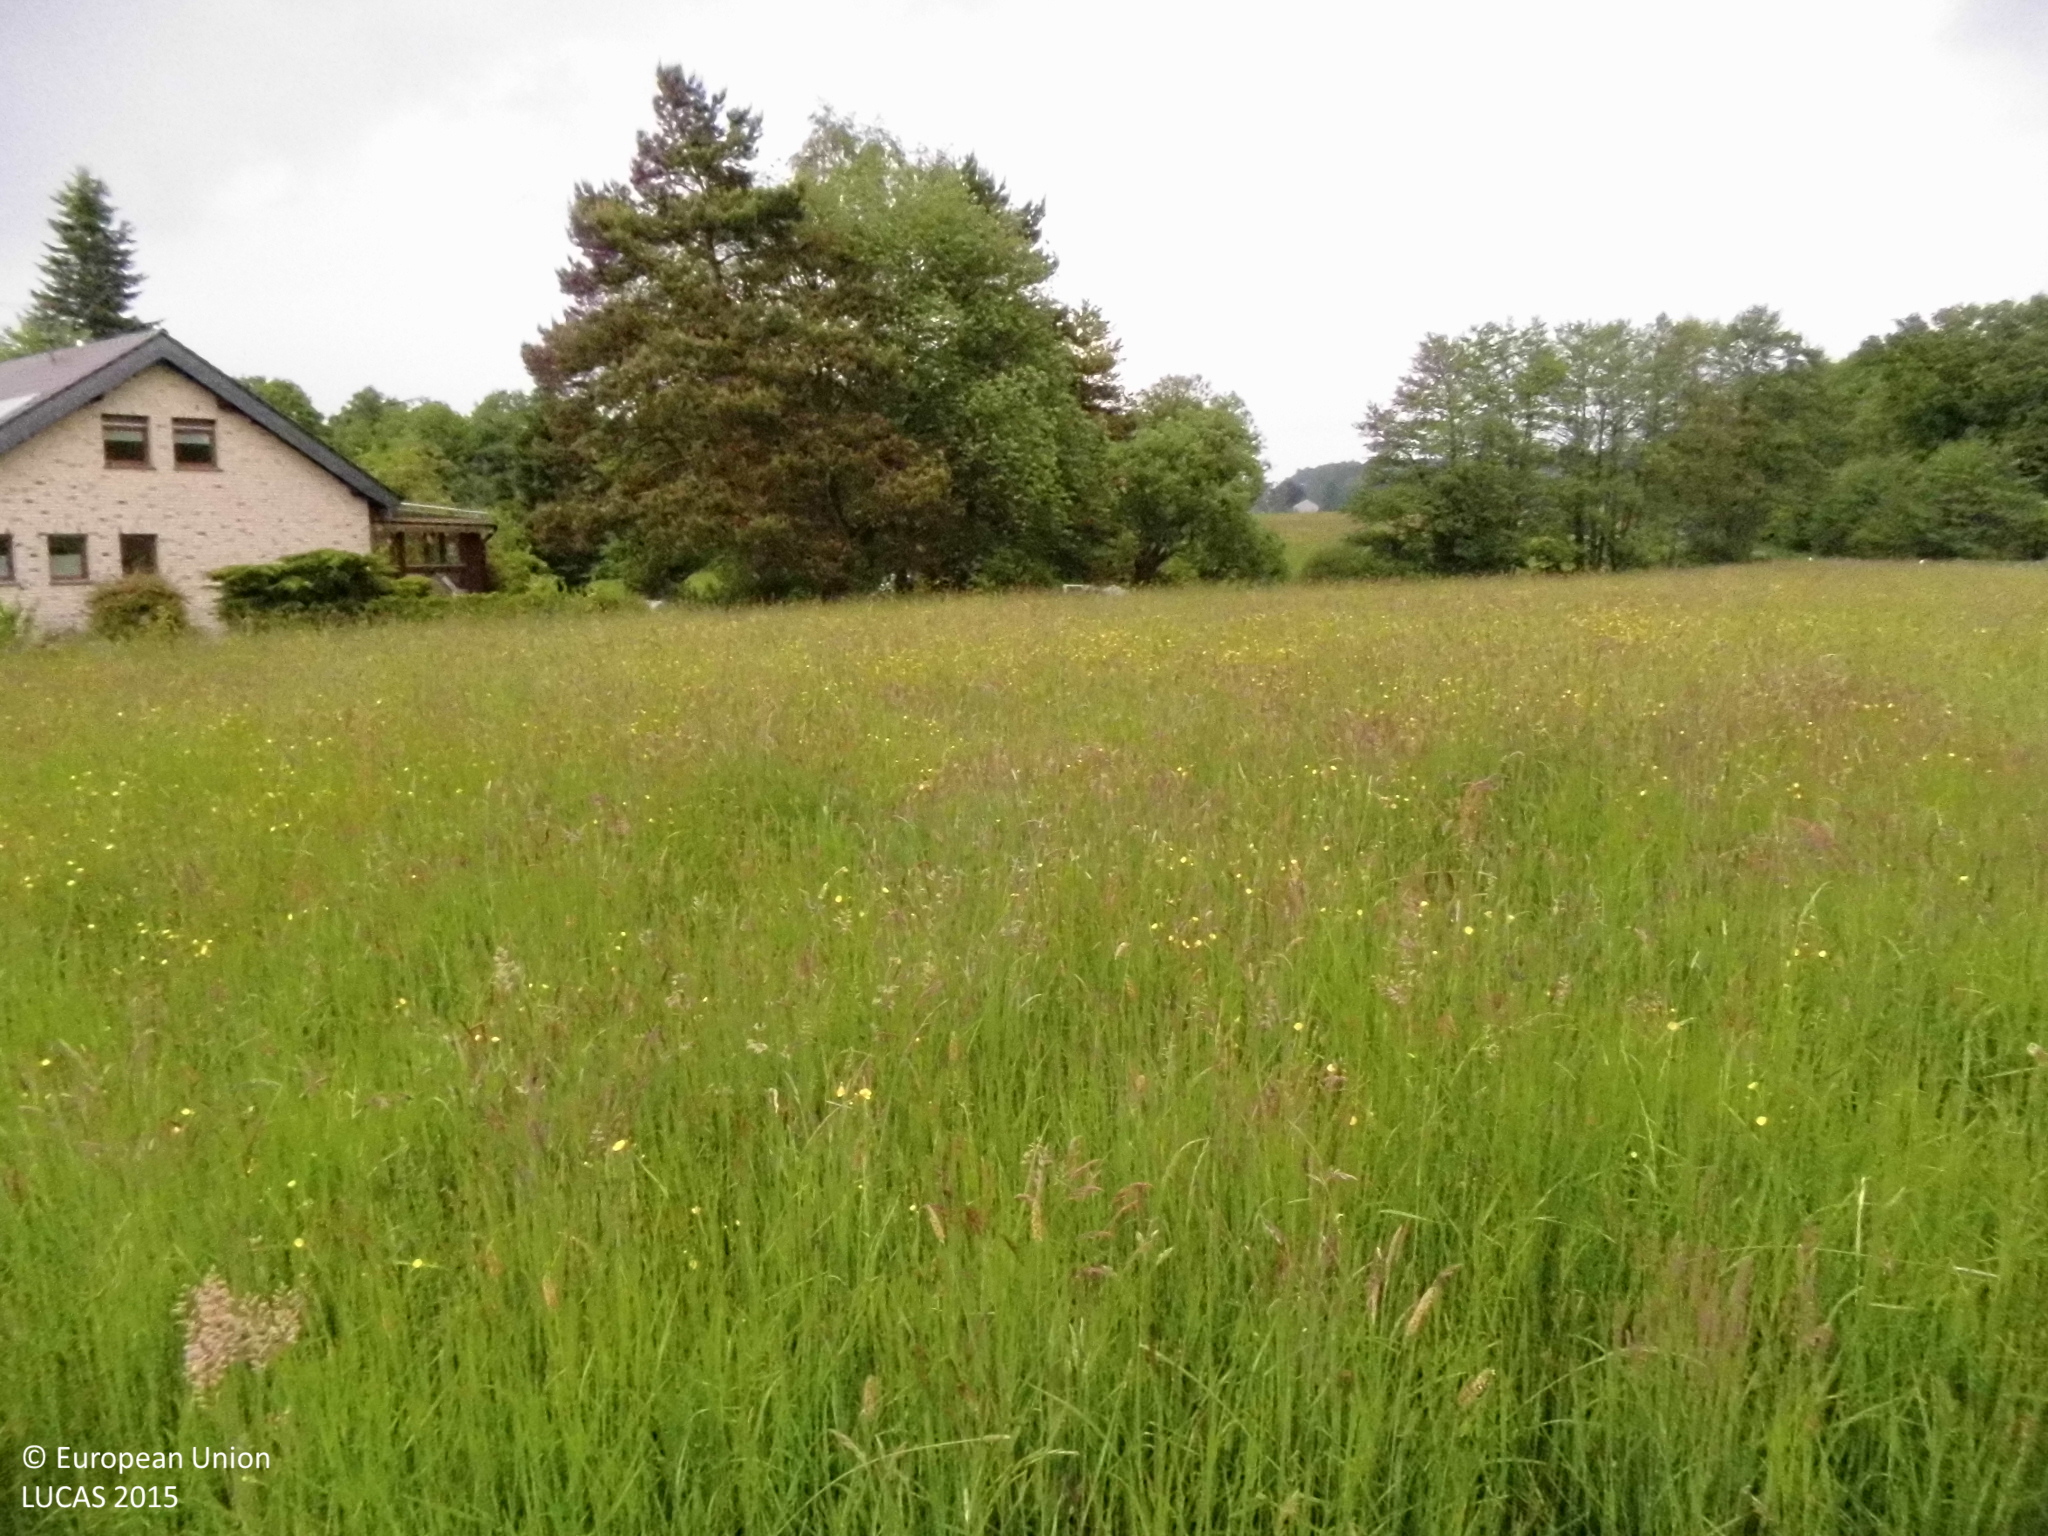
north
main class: Grassland
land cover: Grassland without tree/shrub cover
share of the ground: > 75 %
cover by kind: herbaceous plants 100 %
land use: Agriculture (excluding fallow land and kitchen gardens)
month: May
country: DE
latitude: 50.6958
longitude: 7.4661
